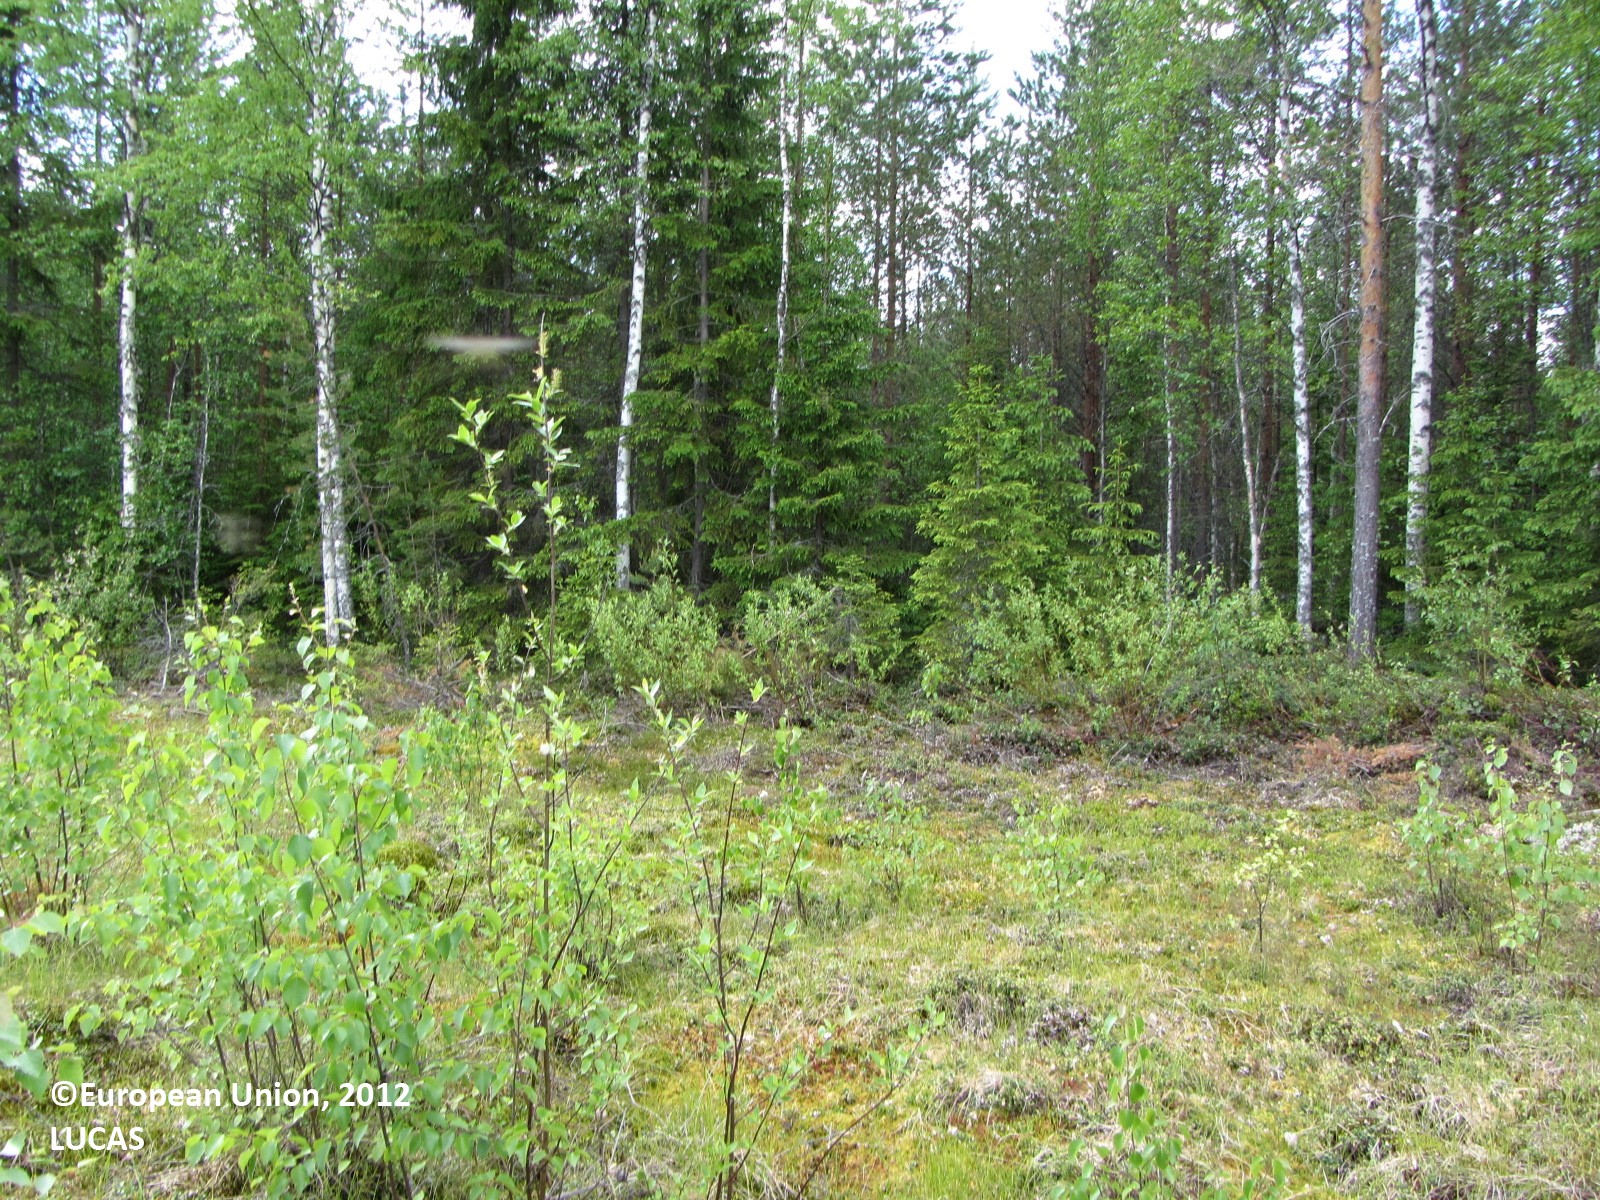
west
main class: Woodland
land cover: Broadleaved woodland
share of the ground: 25 - 50 %
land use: Energy production
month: June
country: FI
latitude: 62.2768
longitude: 25.1942
